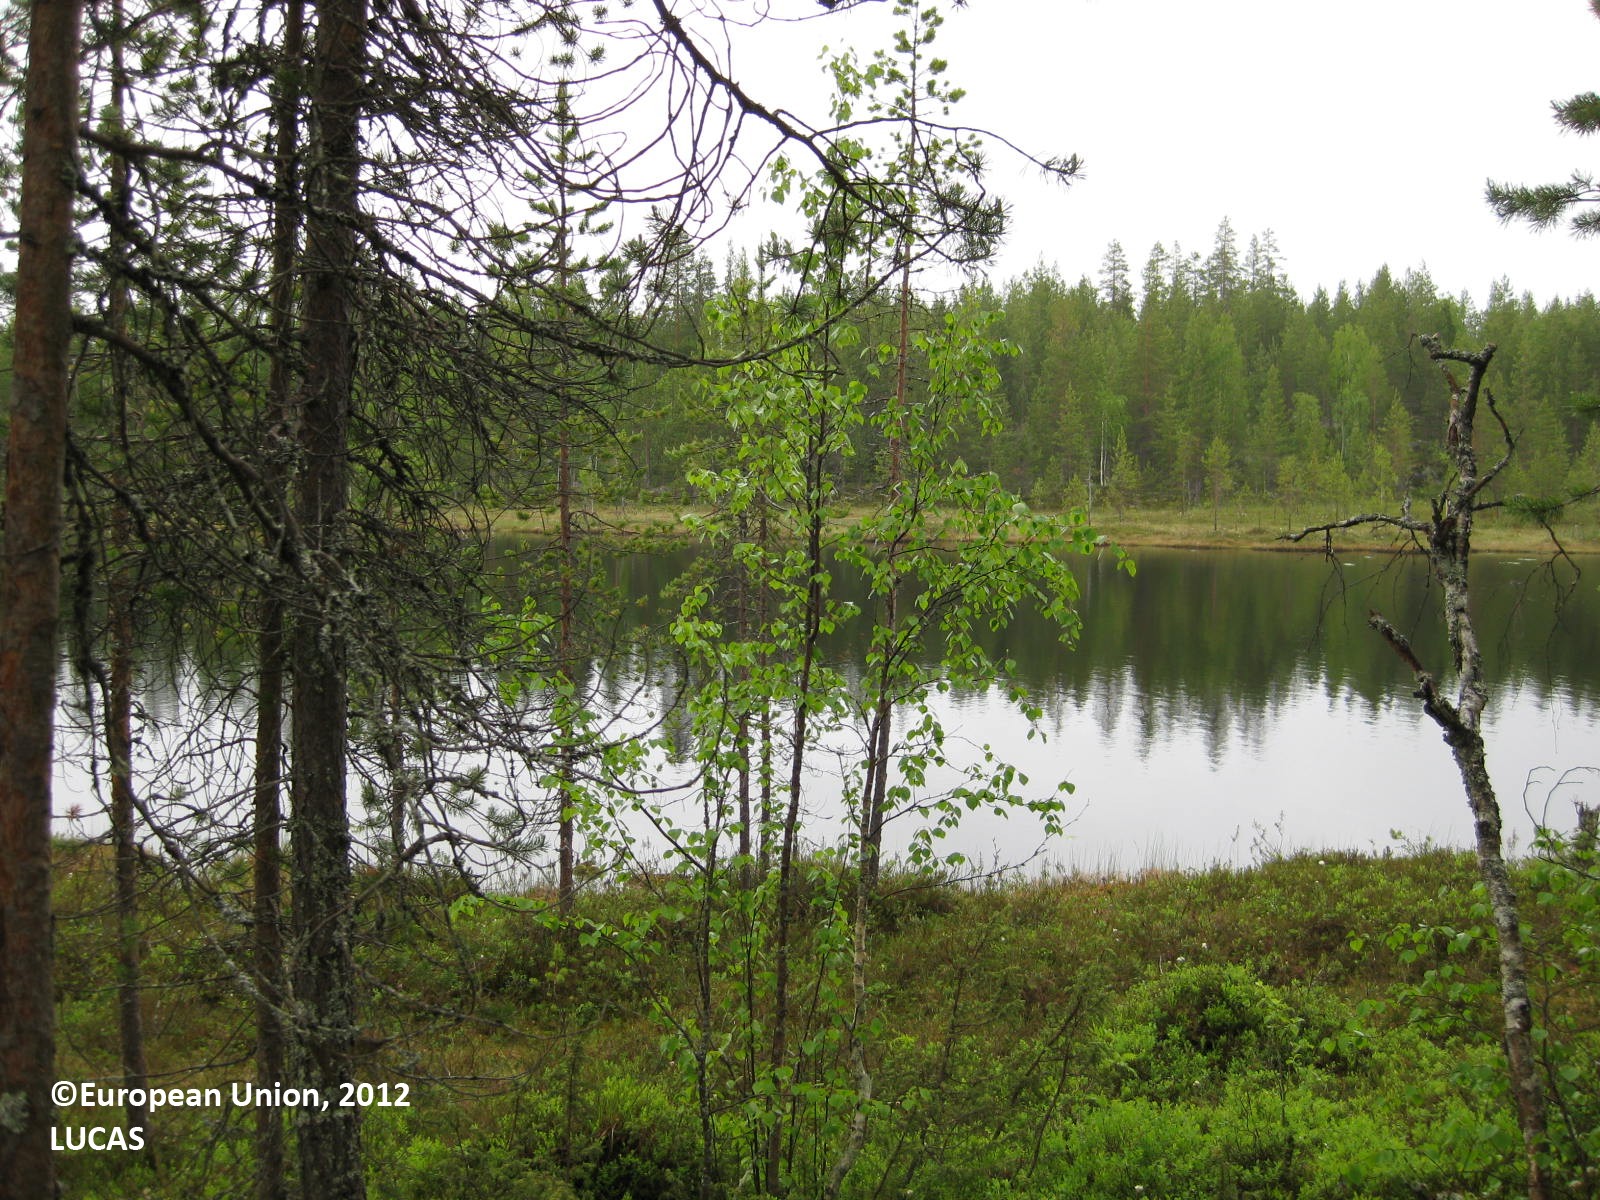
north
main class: Woodland
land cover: Pine dominated mixed woodland
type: boreal forest
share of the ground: 50 - 75 %
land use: Forestry
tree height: > 5 m
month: June
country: FI
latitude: 65.1454
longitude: 29.2790
